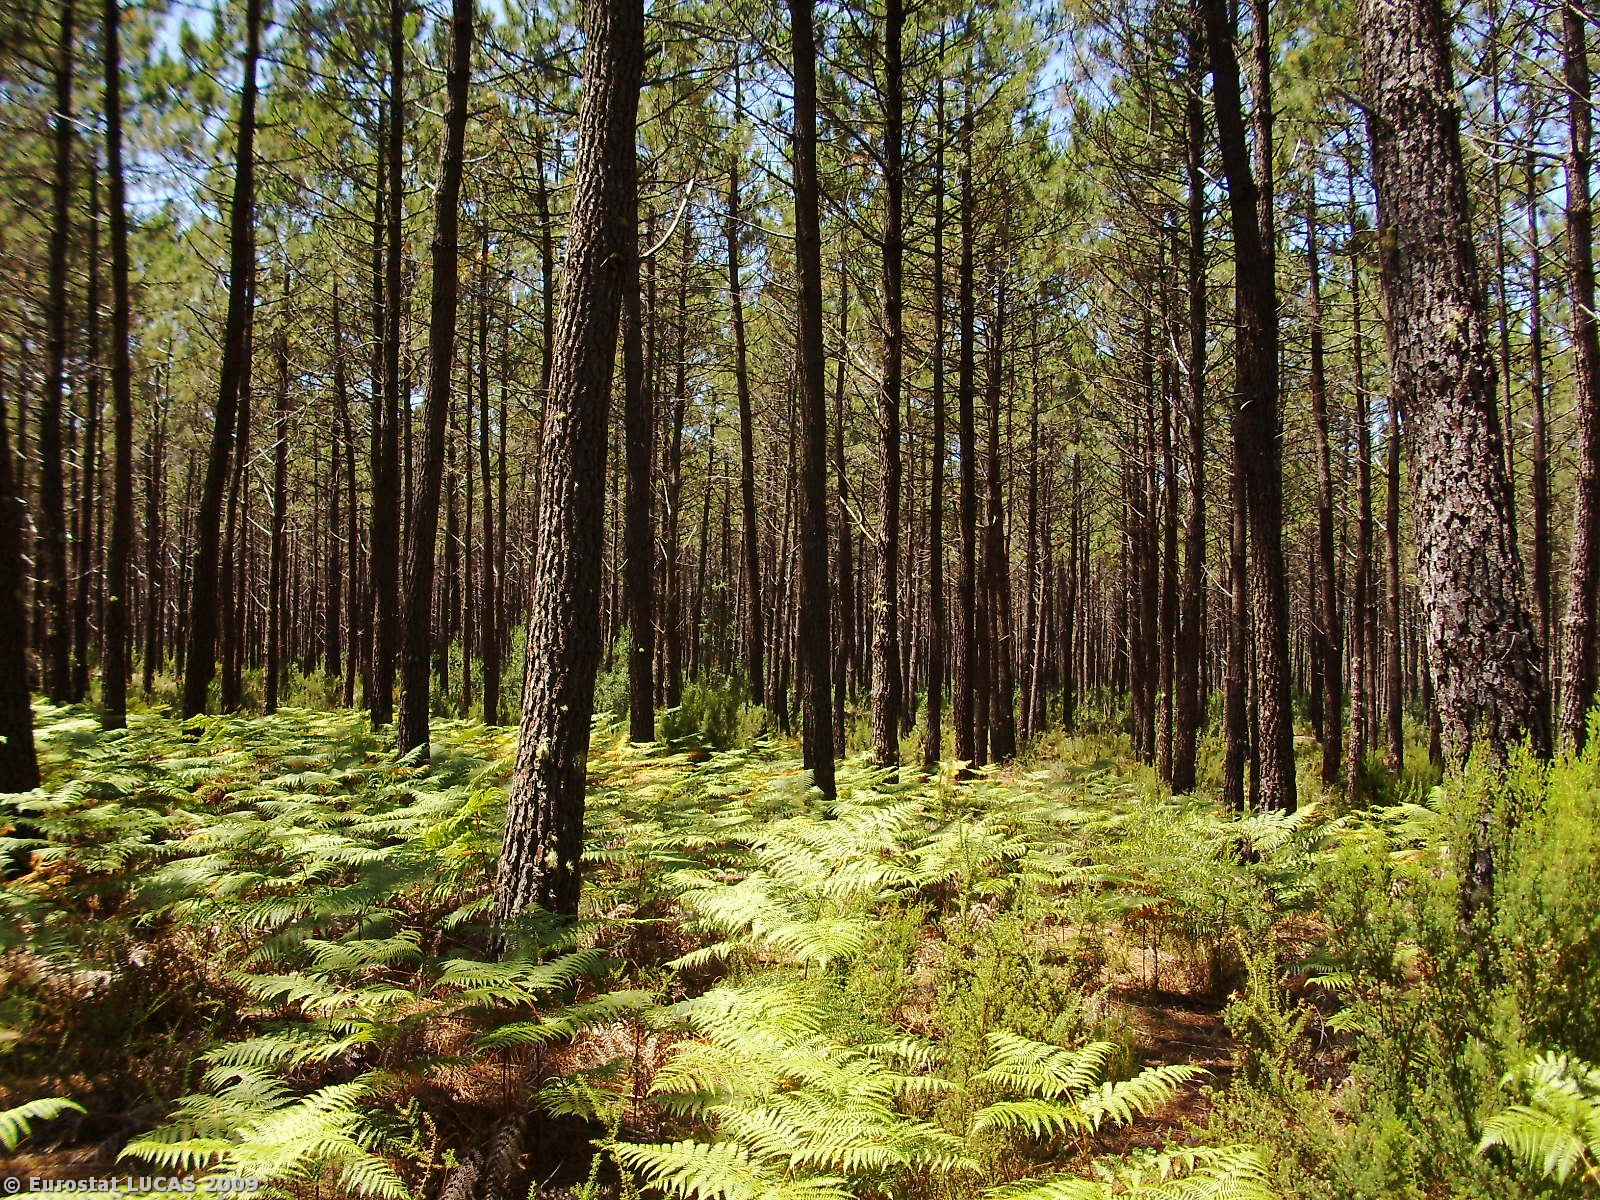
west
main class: Woodland
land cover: Coniferous woodland
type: coniferous forest of the mediterranean region
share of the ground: > 75 %
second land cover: Shrubland with sparse tree cover
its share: 10 - 25 %
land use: Forestry
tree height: > 5 m
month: July
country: PT
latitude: 39.8343
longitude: -8.9154
